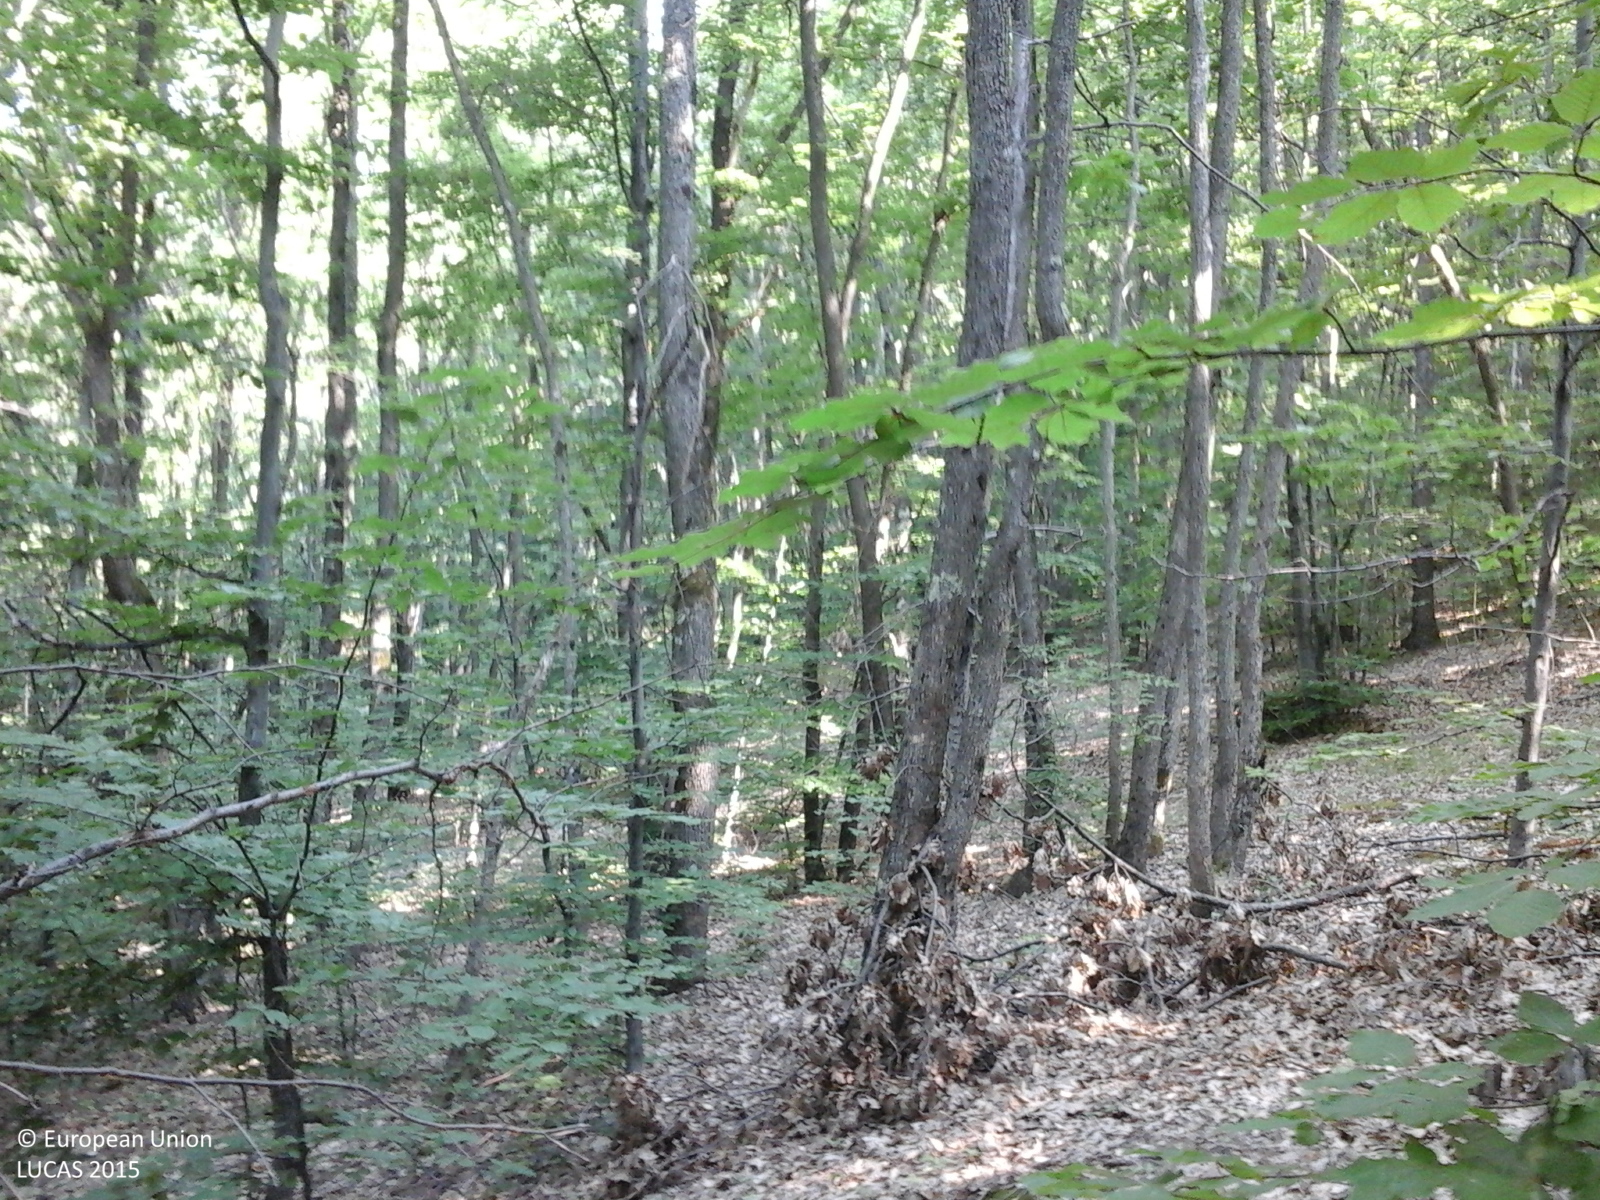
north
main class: Woodland
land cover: Broadleaved woodland
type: acidophilous oak and oak-birch forest
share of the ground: > 75 %
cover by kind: broadleaved forest trees 100 %
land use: Forestry
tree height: > 5 m
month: July
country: RO
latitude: 44.9668
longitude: 24.6715
